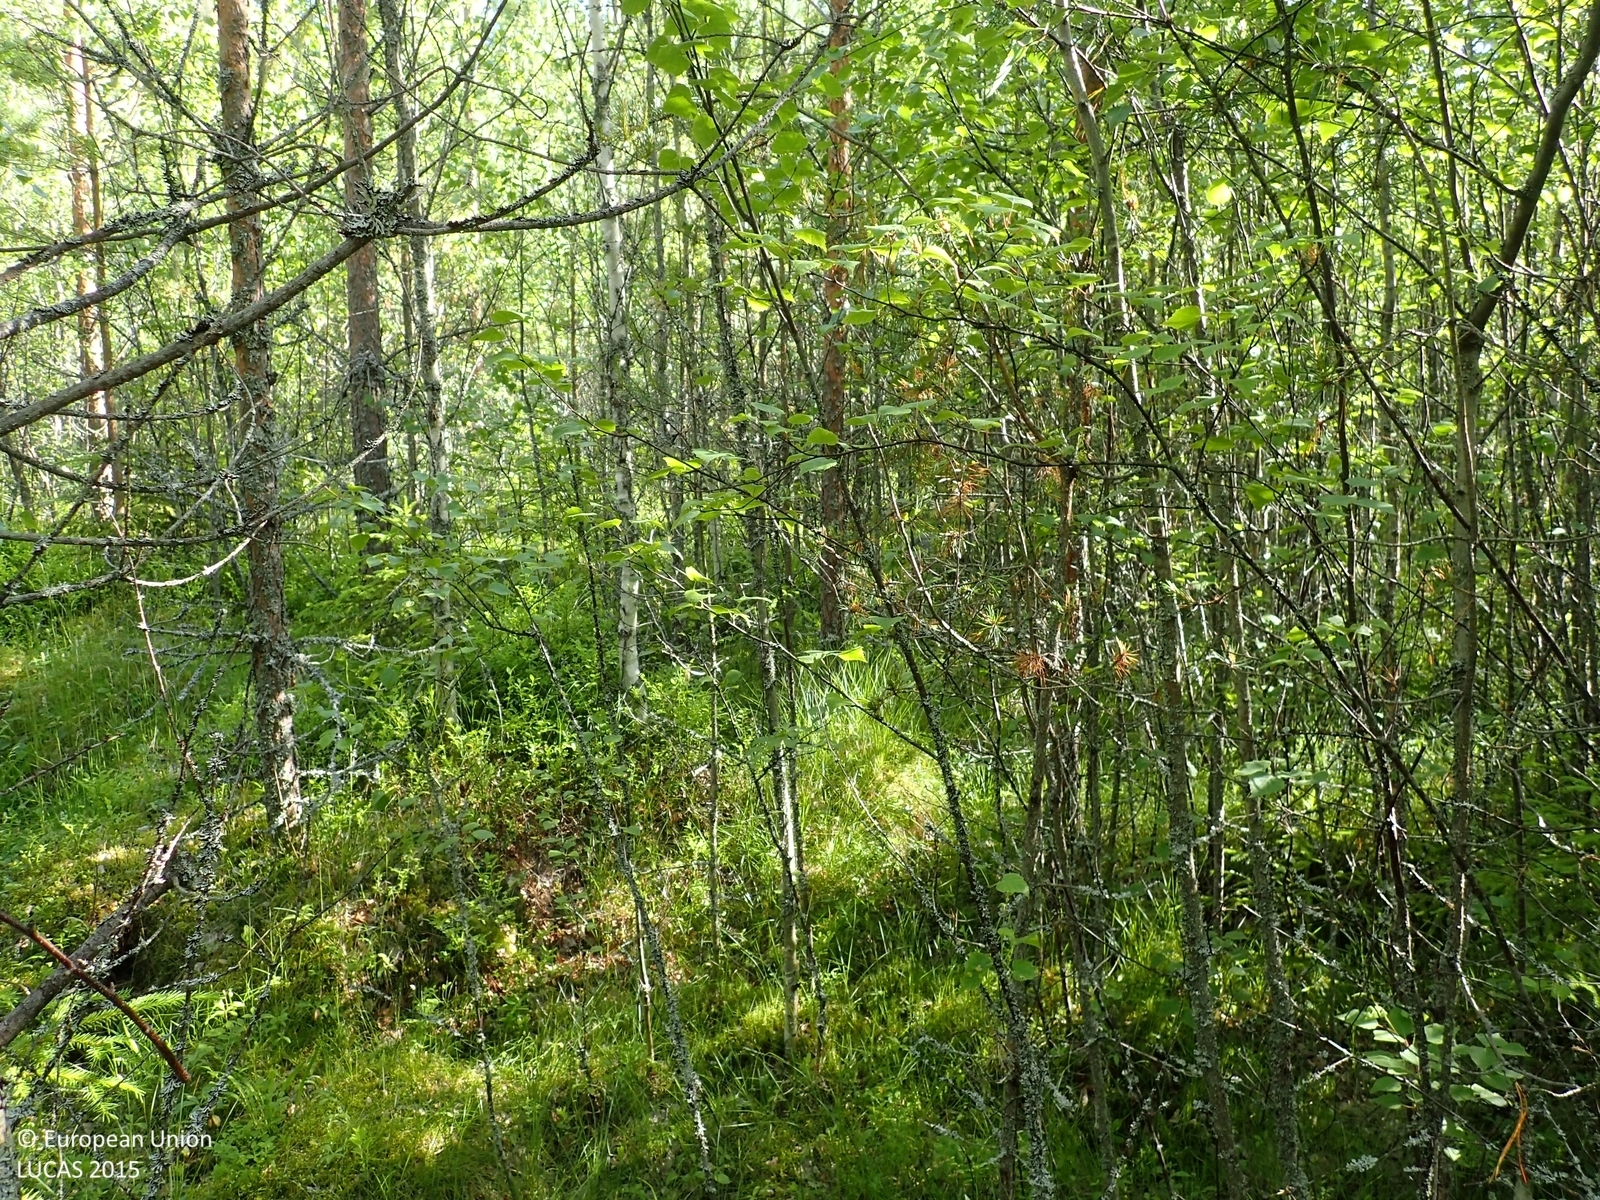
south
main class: Woodland
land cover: Pine dominated mixed woodland
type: boreal forest
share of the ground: > 75 %
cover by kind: coniferous forest trees 40 %, broadleaved forest trees 40 %, shrubs 10 %, herbaceous plants 10 %
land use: Forestry
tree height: > 5 m
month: June
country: FI
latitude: 62.5036
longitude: 21.4392
